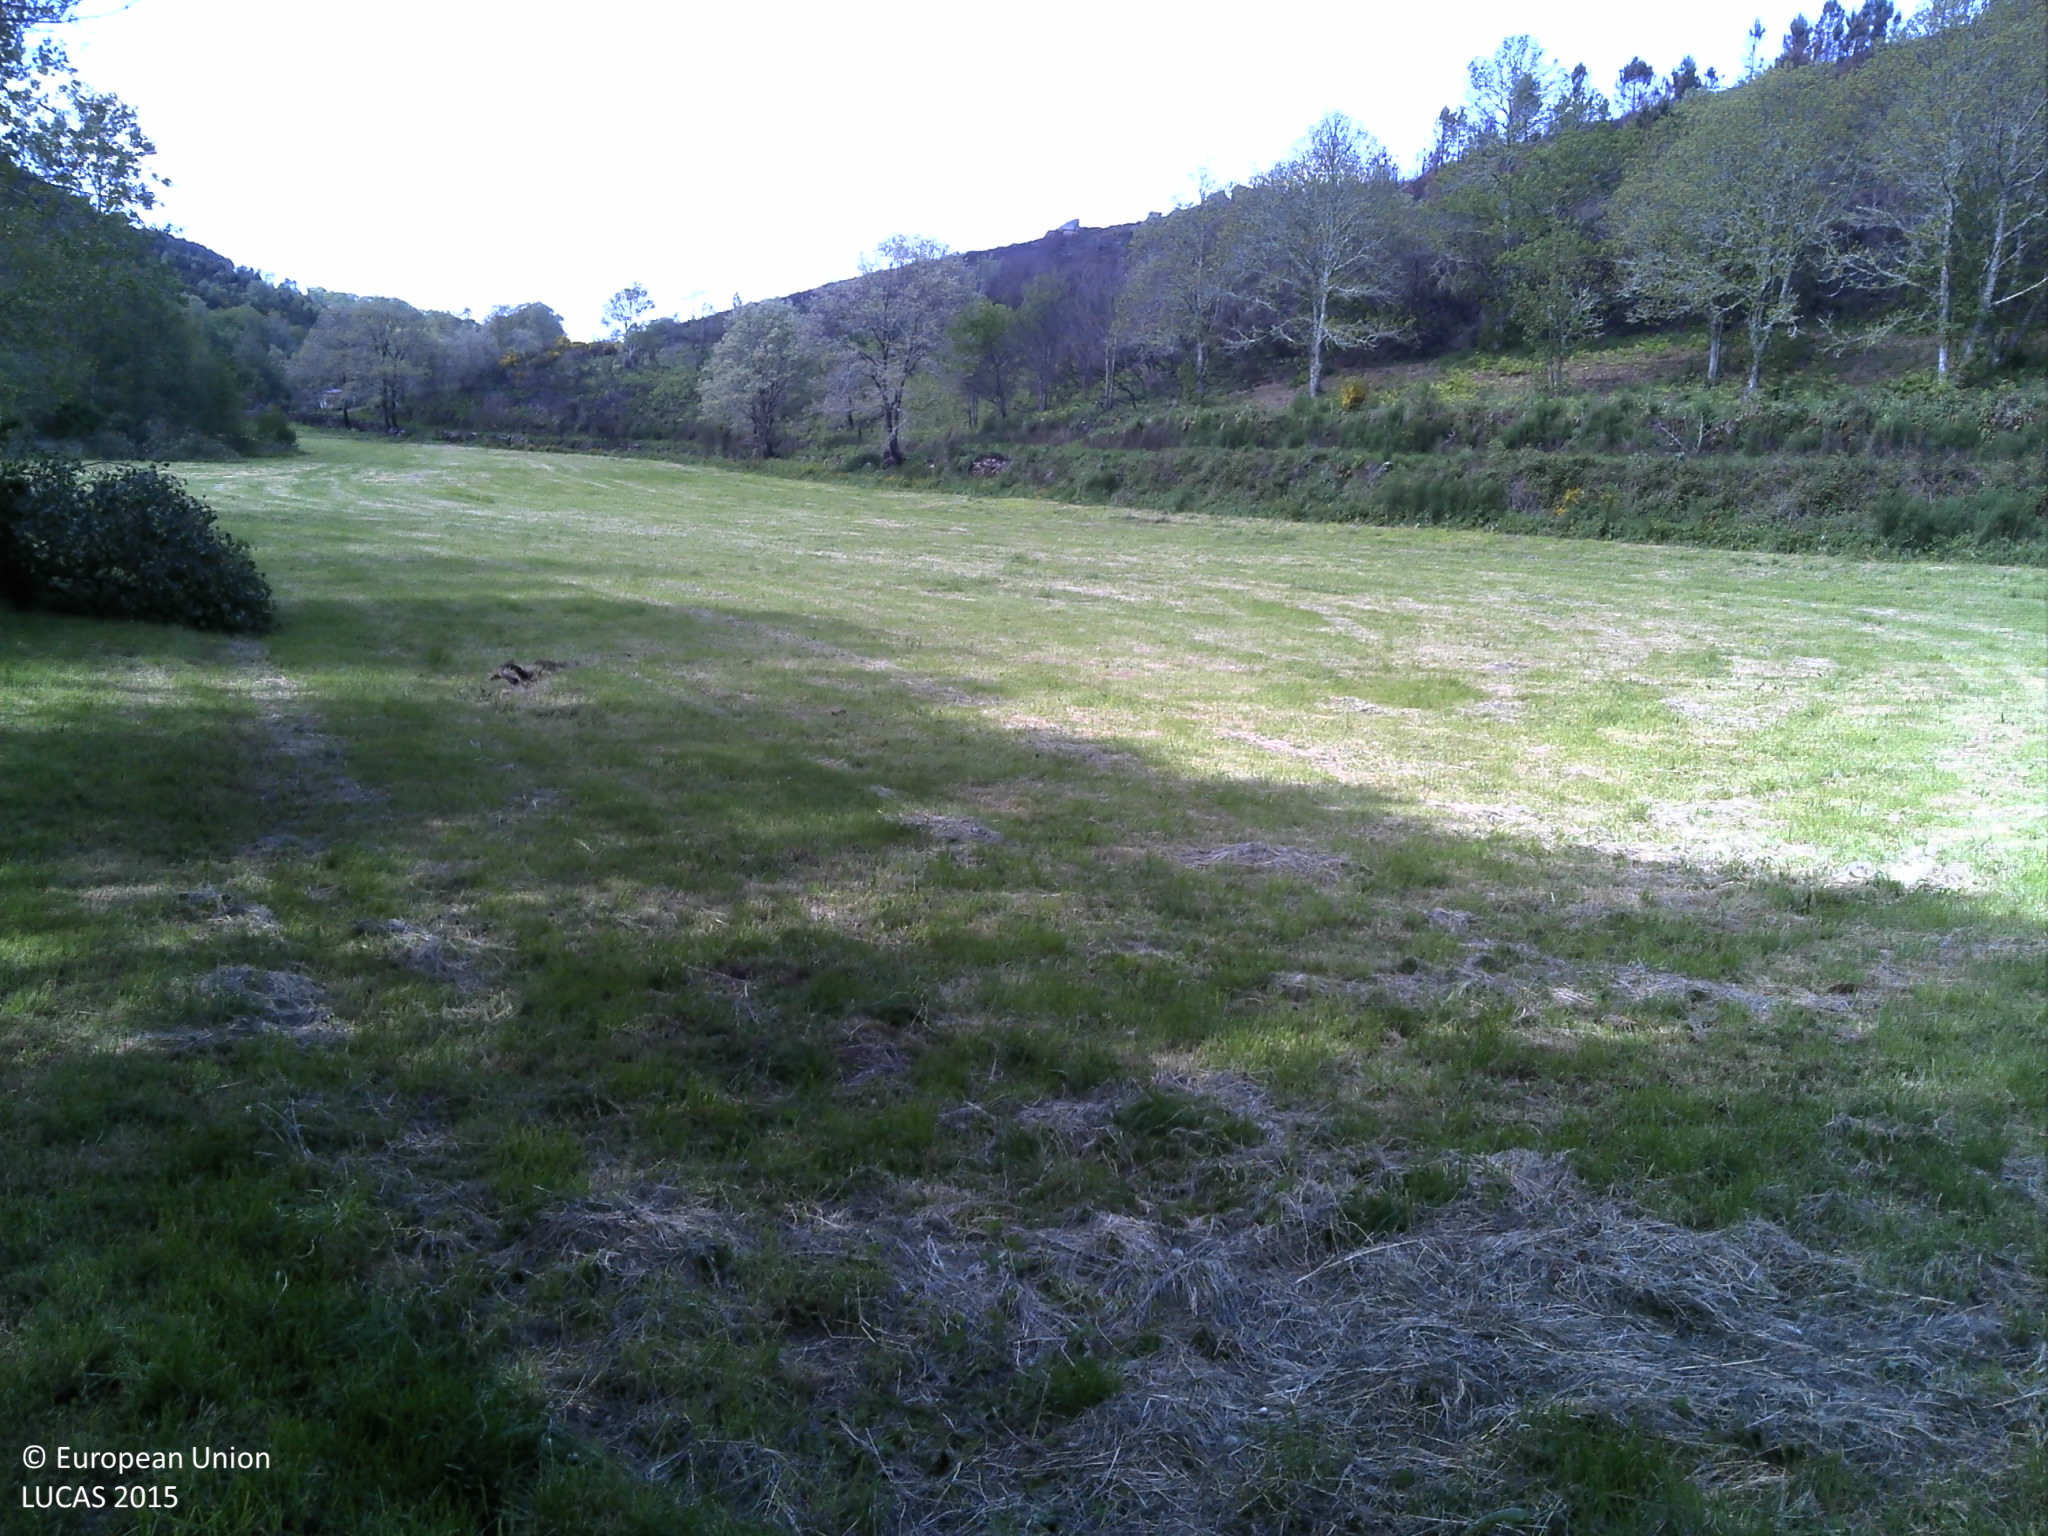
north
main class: Shrubland
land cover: Shrubland with sparse tree cover
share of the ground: 50 - 75 %
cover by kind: shrubs 75 %, herbaceous plants 20 %, broadleaved forest trees 5 %
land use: Semi-natural and natural areas not in use
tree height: > 5 m
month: May
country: PT
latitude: 41.5327
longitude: -7.5438
